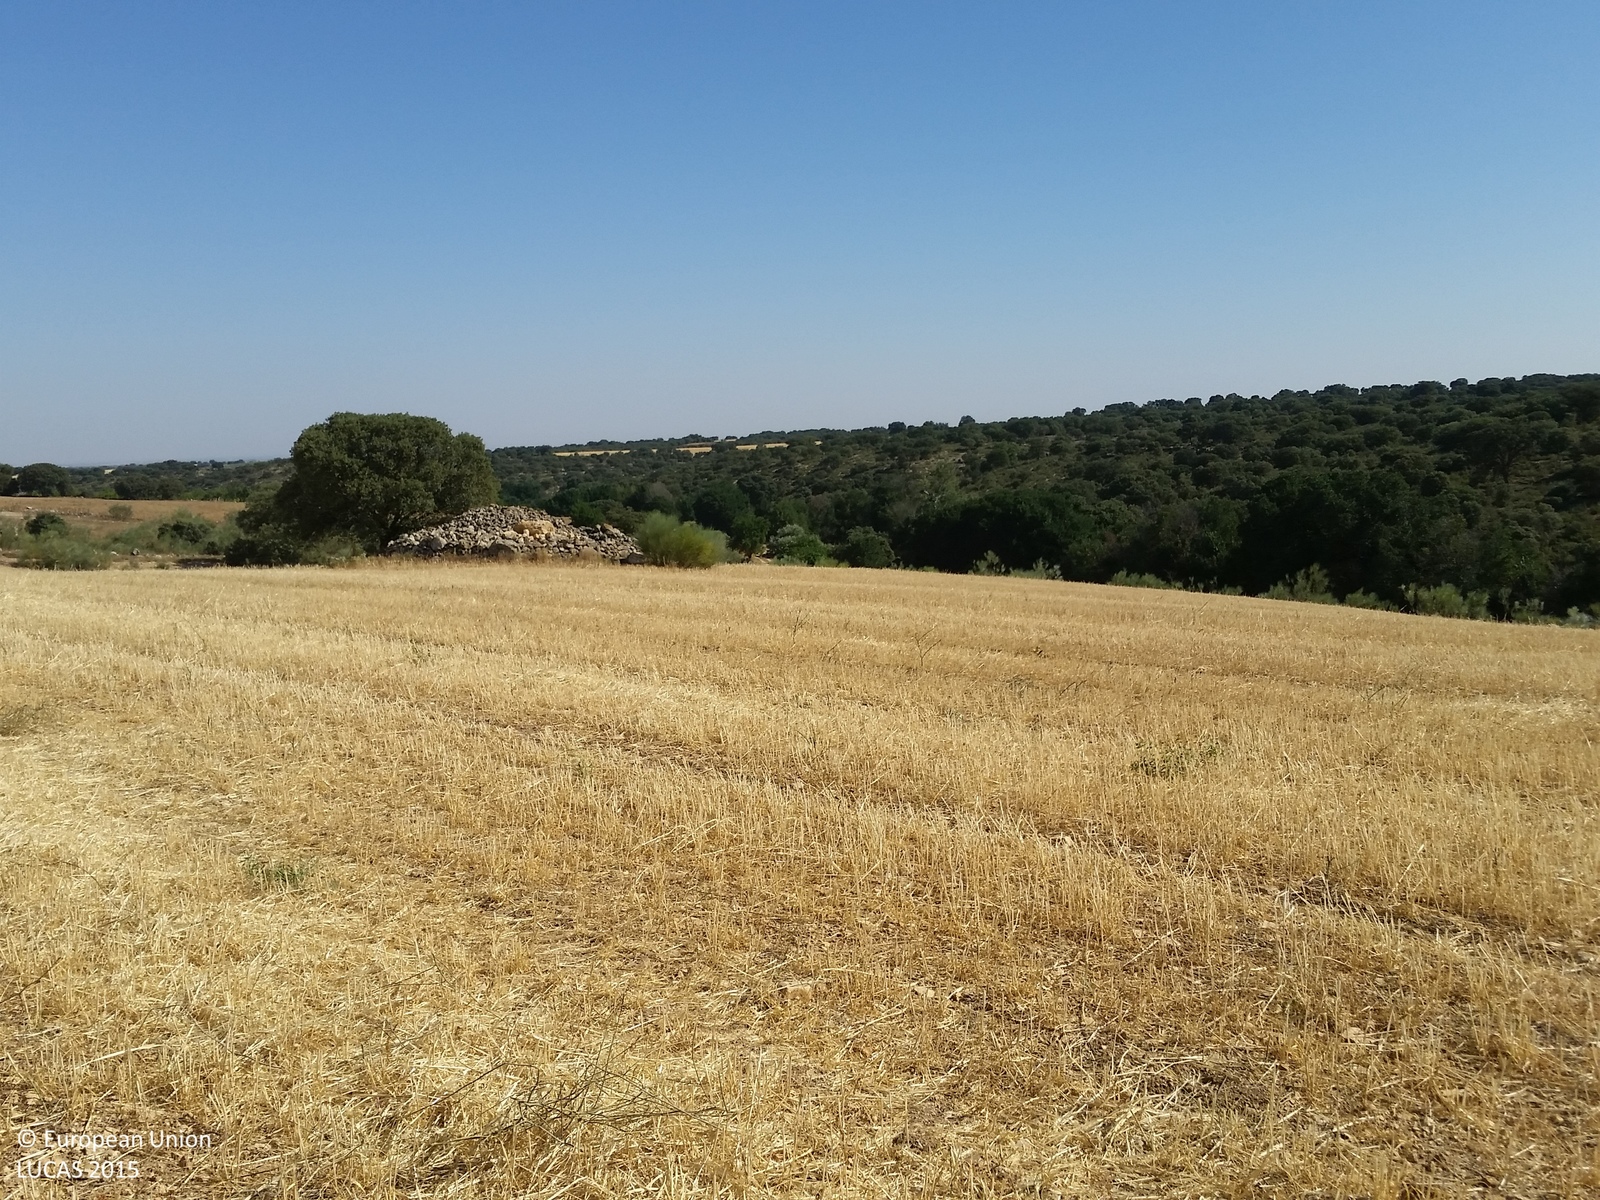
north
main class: Cropland
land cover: Barley
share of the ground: < 10 %
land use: Agriculture (excluding fallow land and kitchen gardens)
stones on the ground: 10 - 25 %
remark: Harvested field
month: July
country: ES
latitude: 39.0027
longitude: -2.5346
